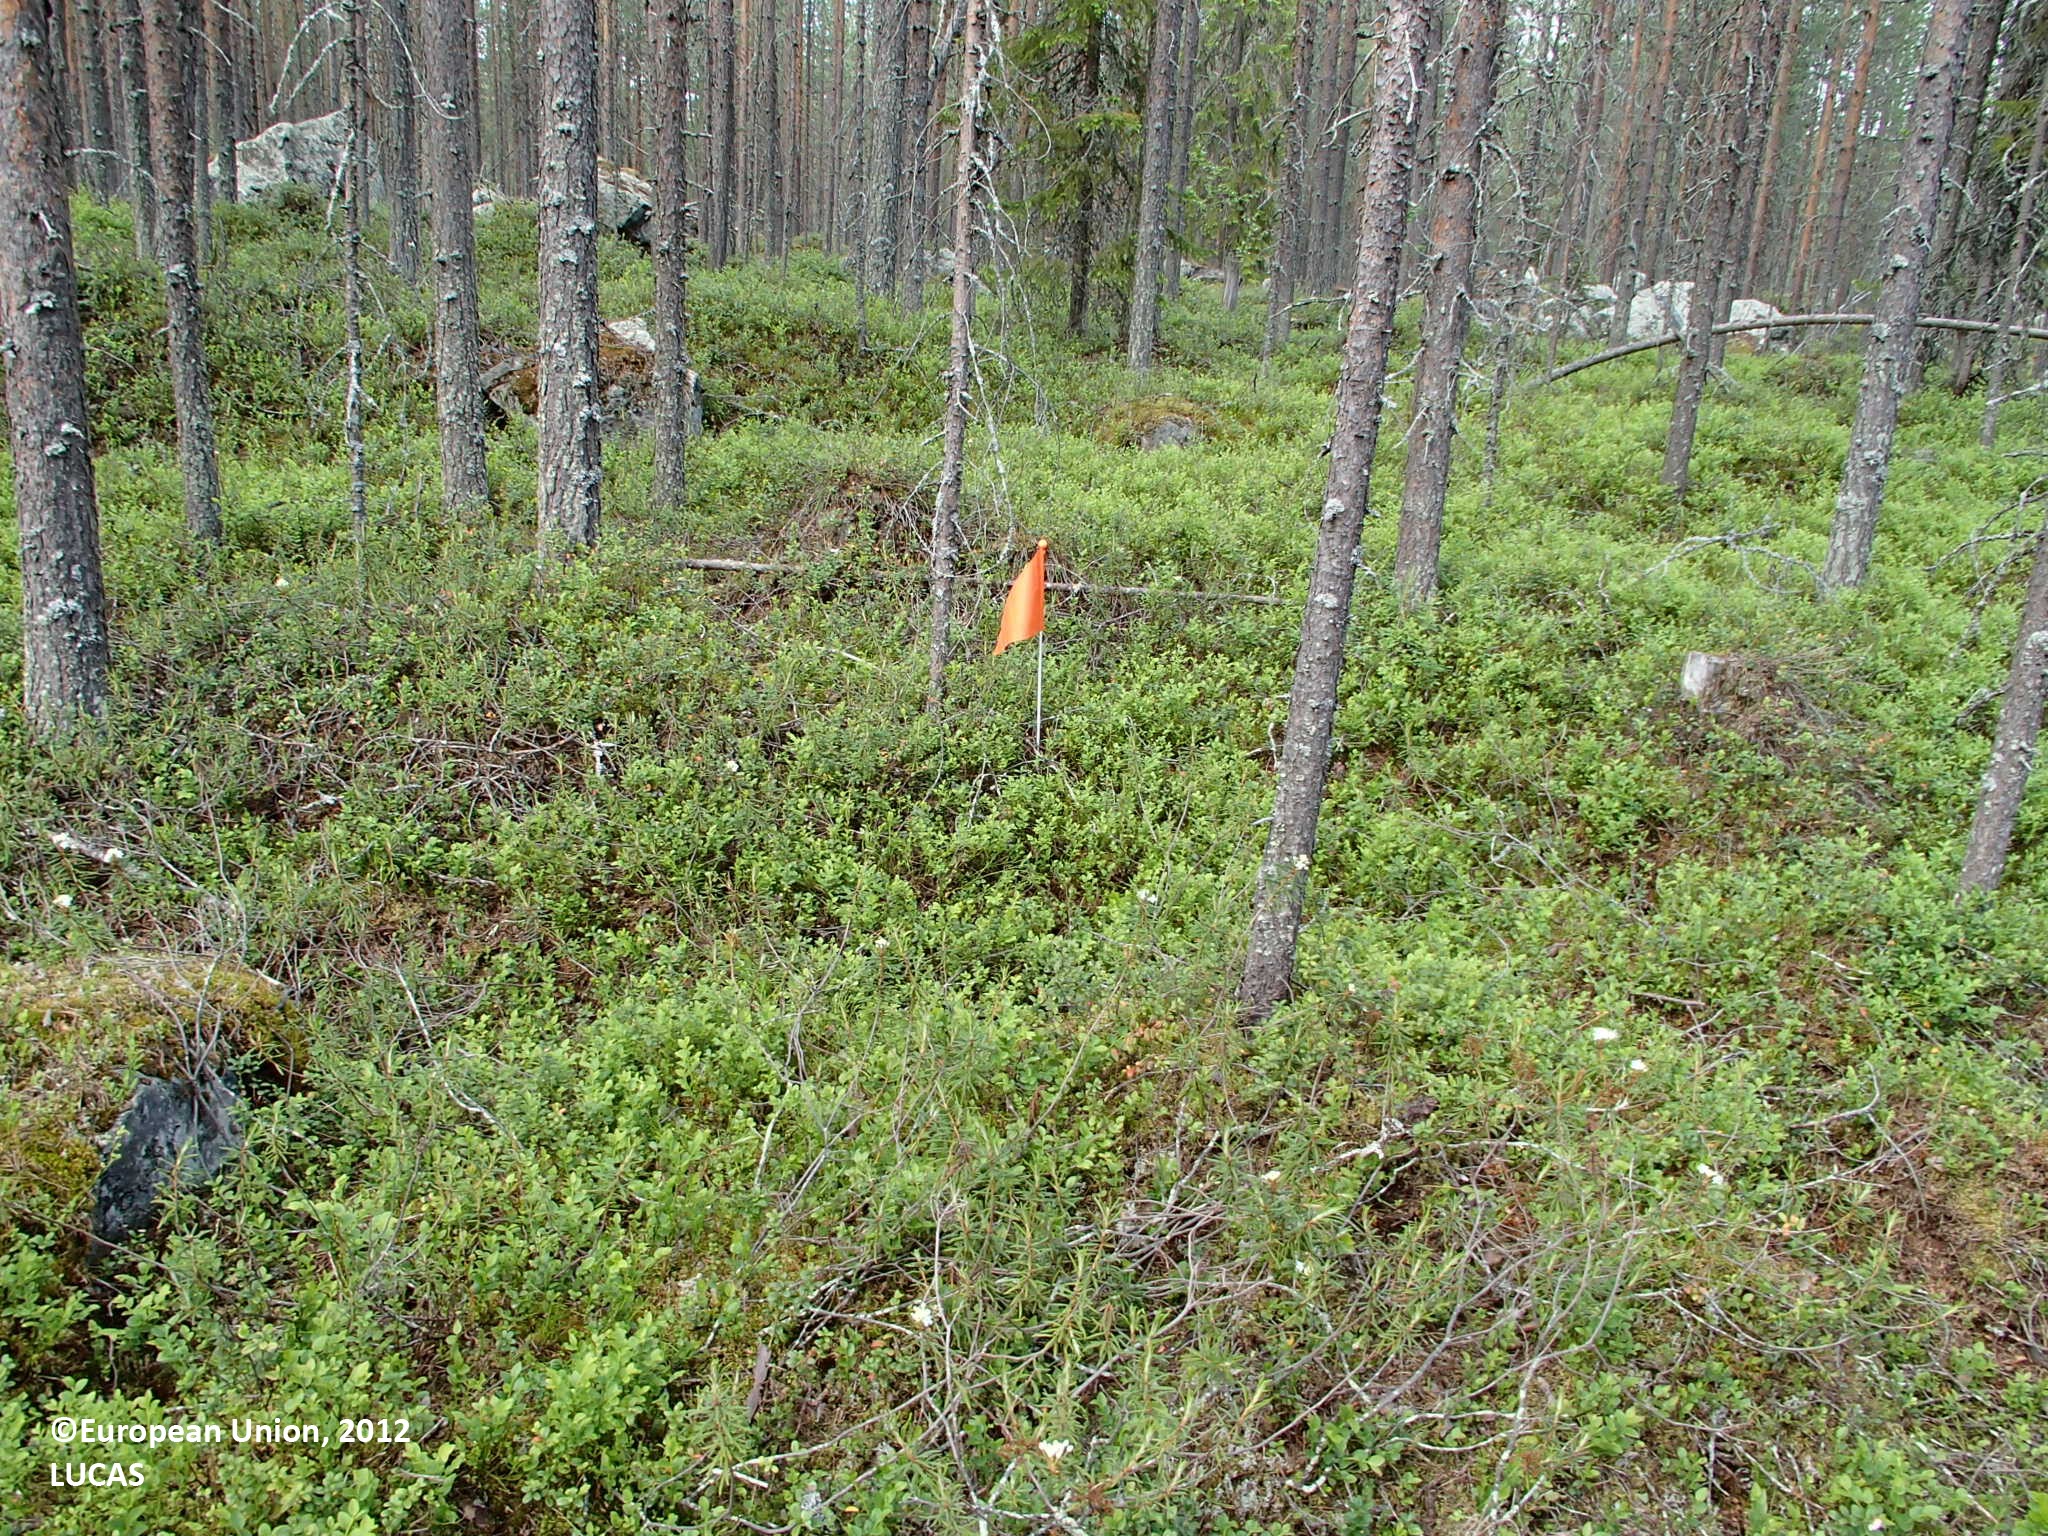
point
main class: Woodland
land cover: Pine dominated coniferous woodland
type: boreal forest
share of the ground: > 75 %
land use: Forestry
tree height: > 5 m
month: June
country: FI
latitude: 66.5785
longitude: 27.1701
